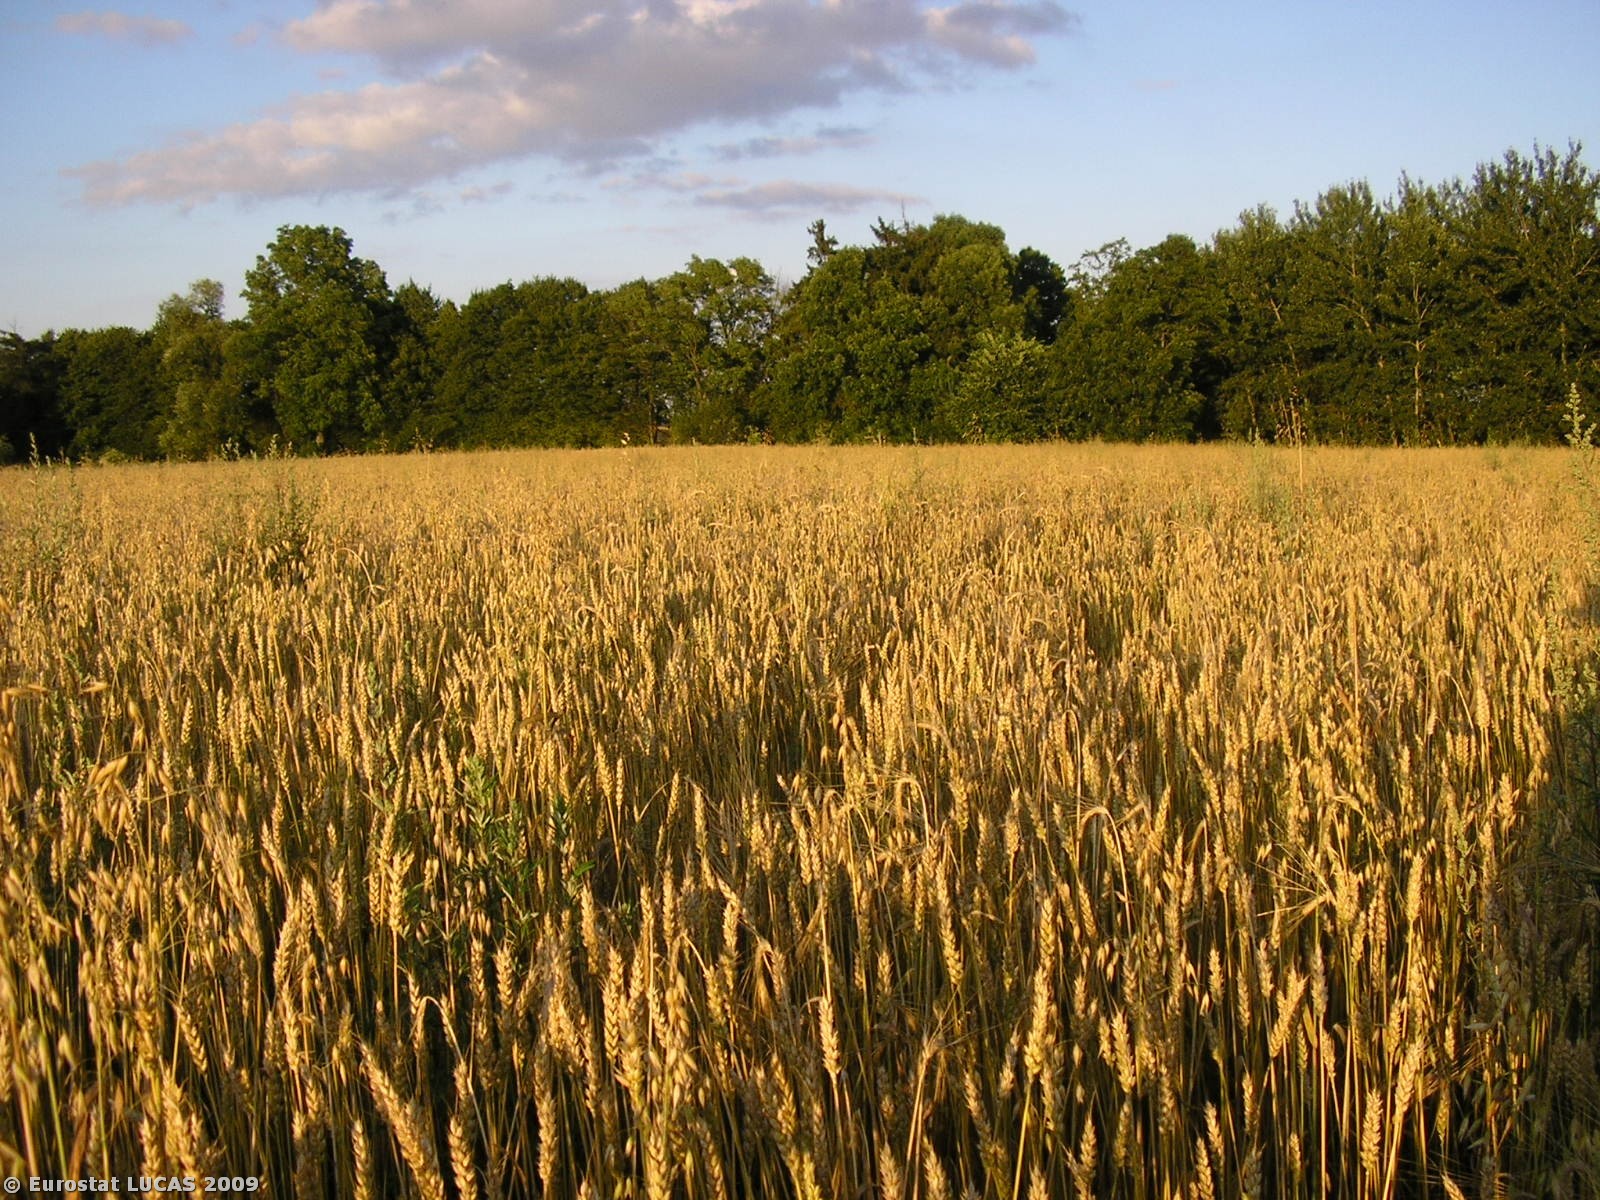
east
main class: Cropland
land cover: Mixed cereals for fodder
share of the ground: > 75 %
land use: Agriculture (excluding fallow land and kitchen gardens)
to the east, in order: Mixed cereals for fodder; Rivers and streams; Broadleaved woodland; Common wheat
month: July
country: PL
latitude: 52.3895
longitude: 22.3031
